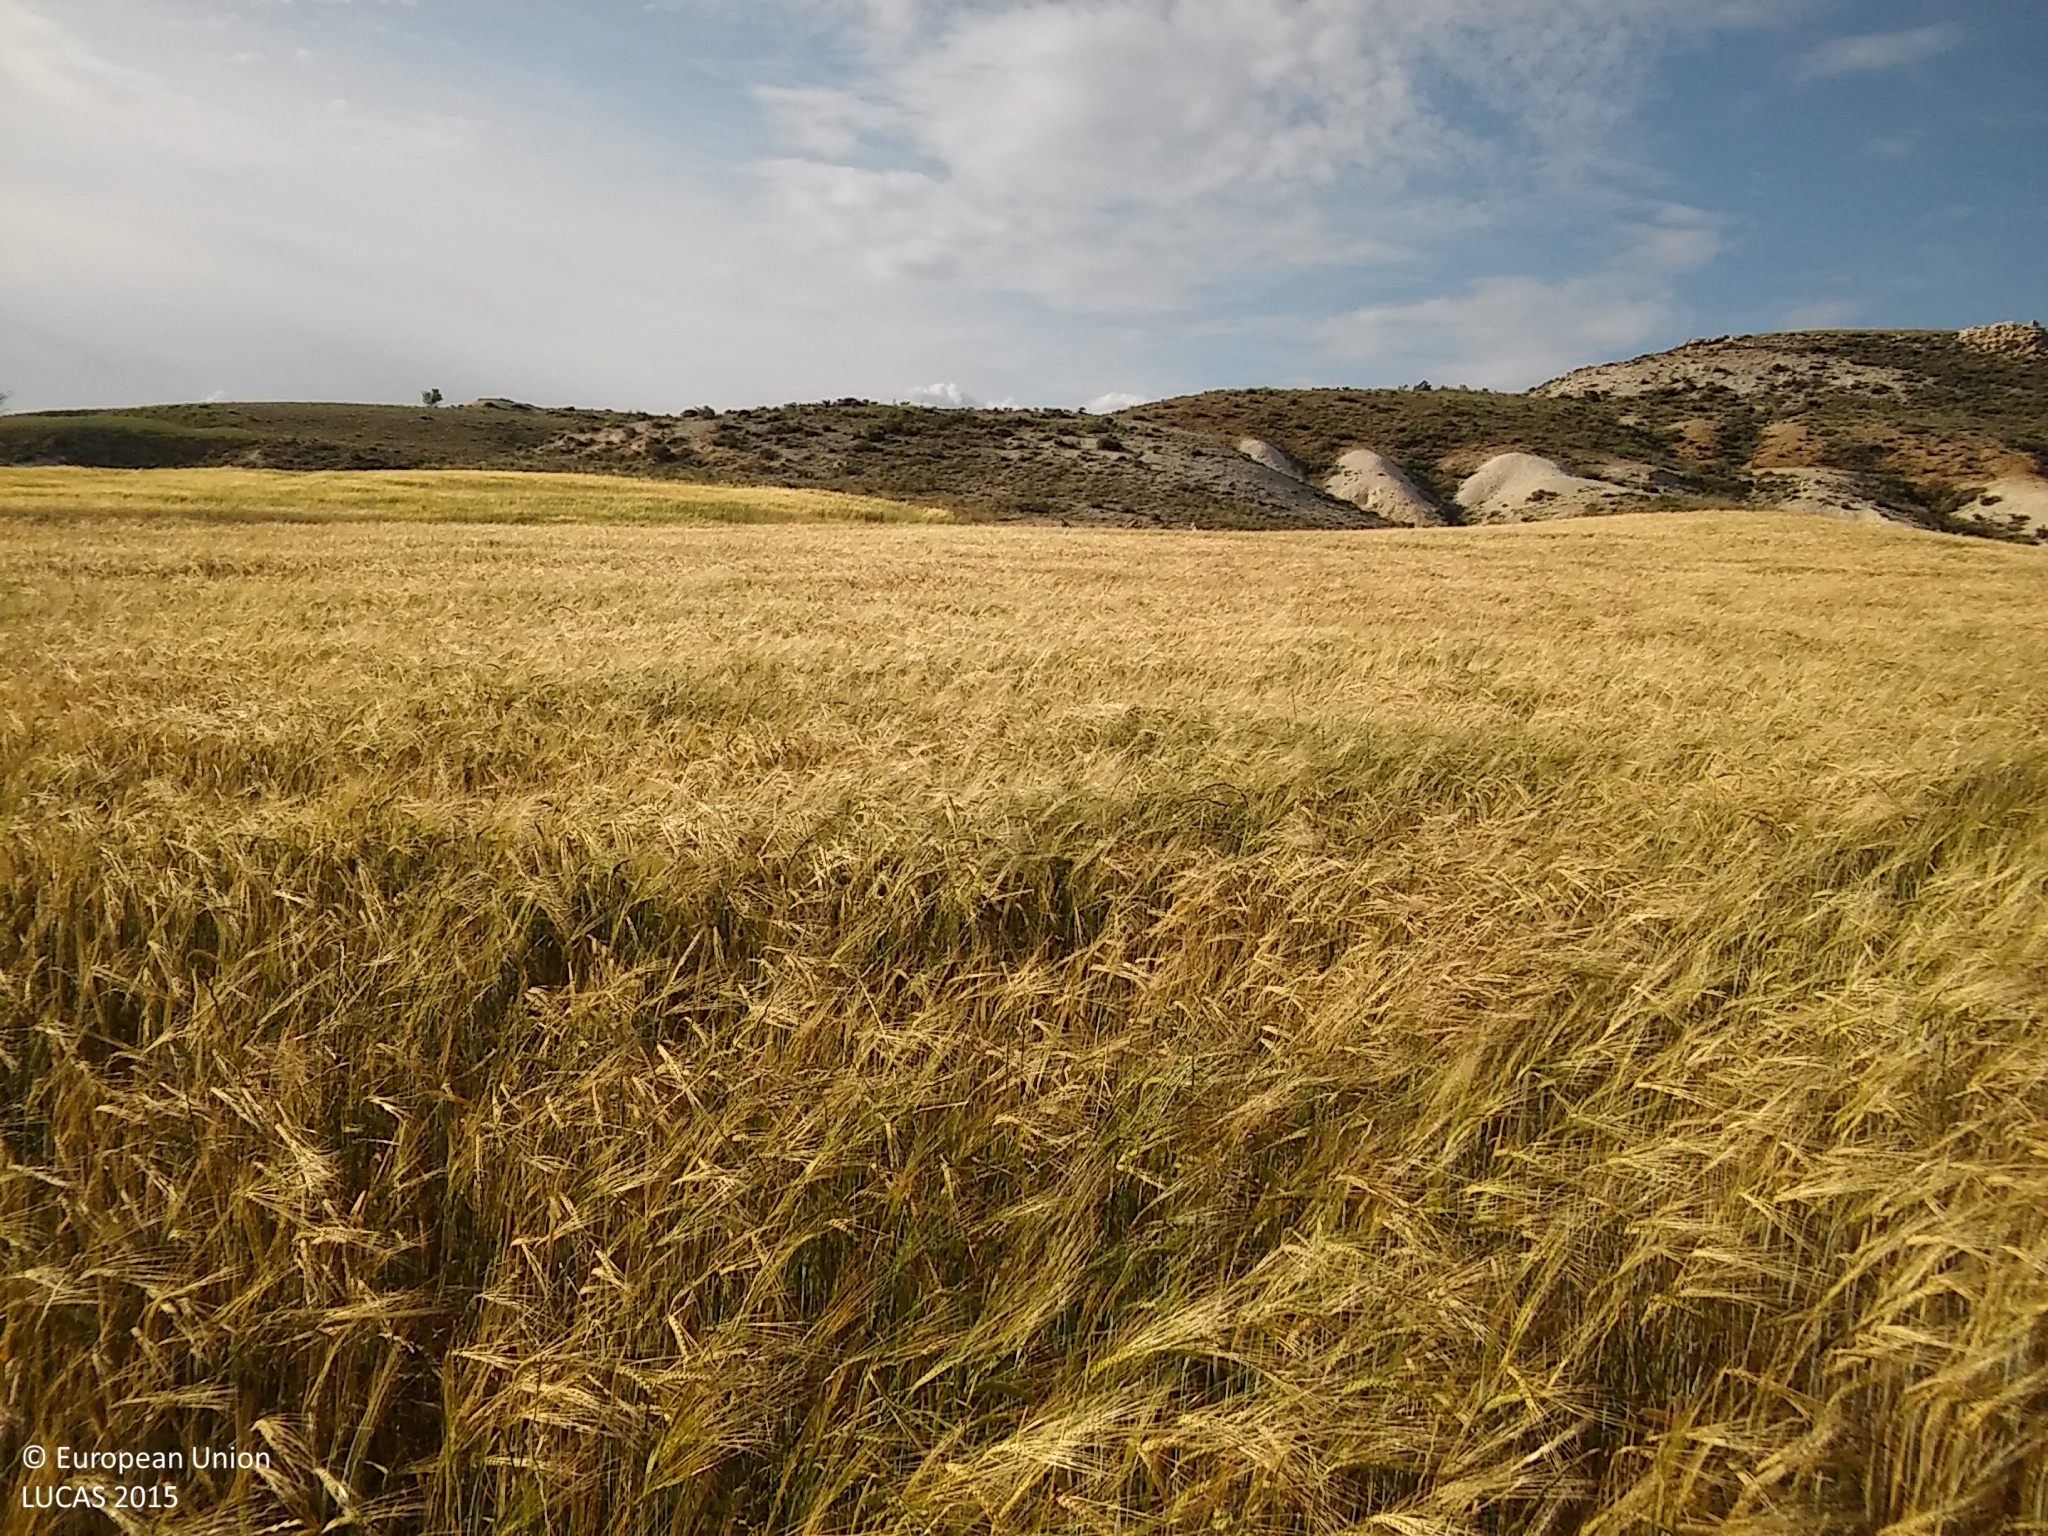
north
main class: Cropland
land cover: Barley
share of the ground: > 75 %
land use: Agriculture (excluding fallow land and kitchen gardens)
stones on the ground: 25 - 50 %
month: June
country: ES
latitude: 41.5571
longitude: -3.8057
